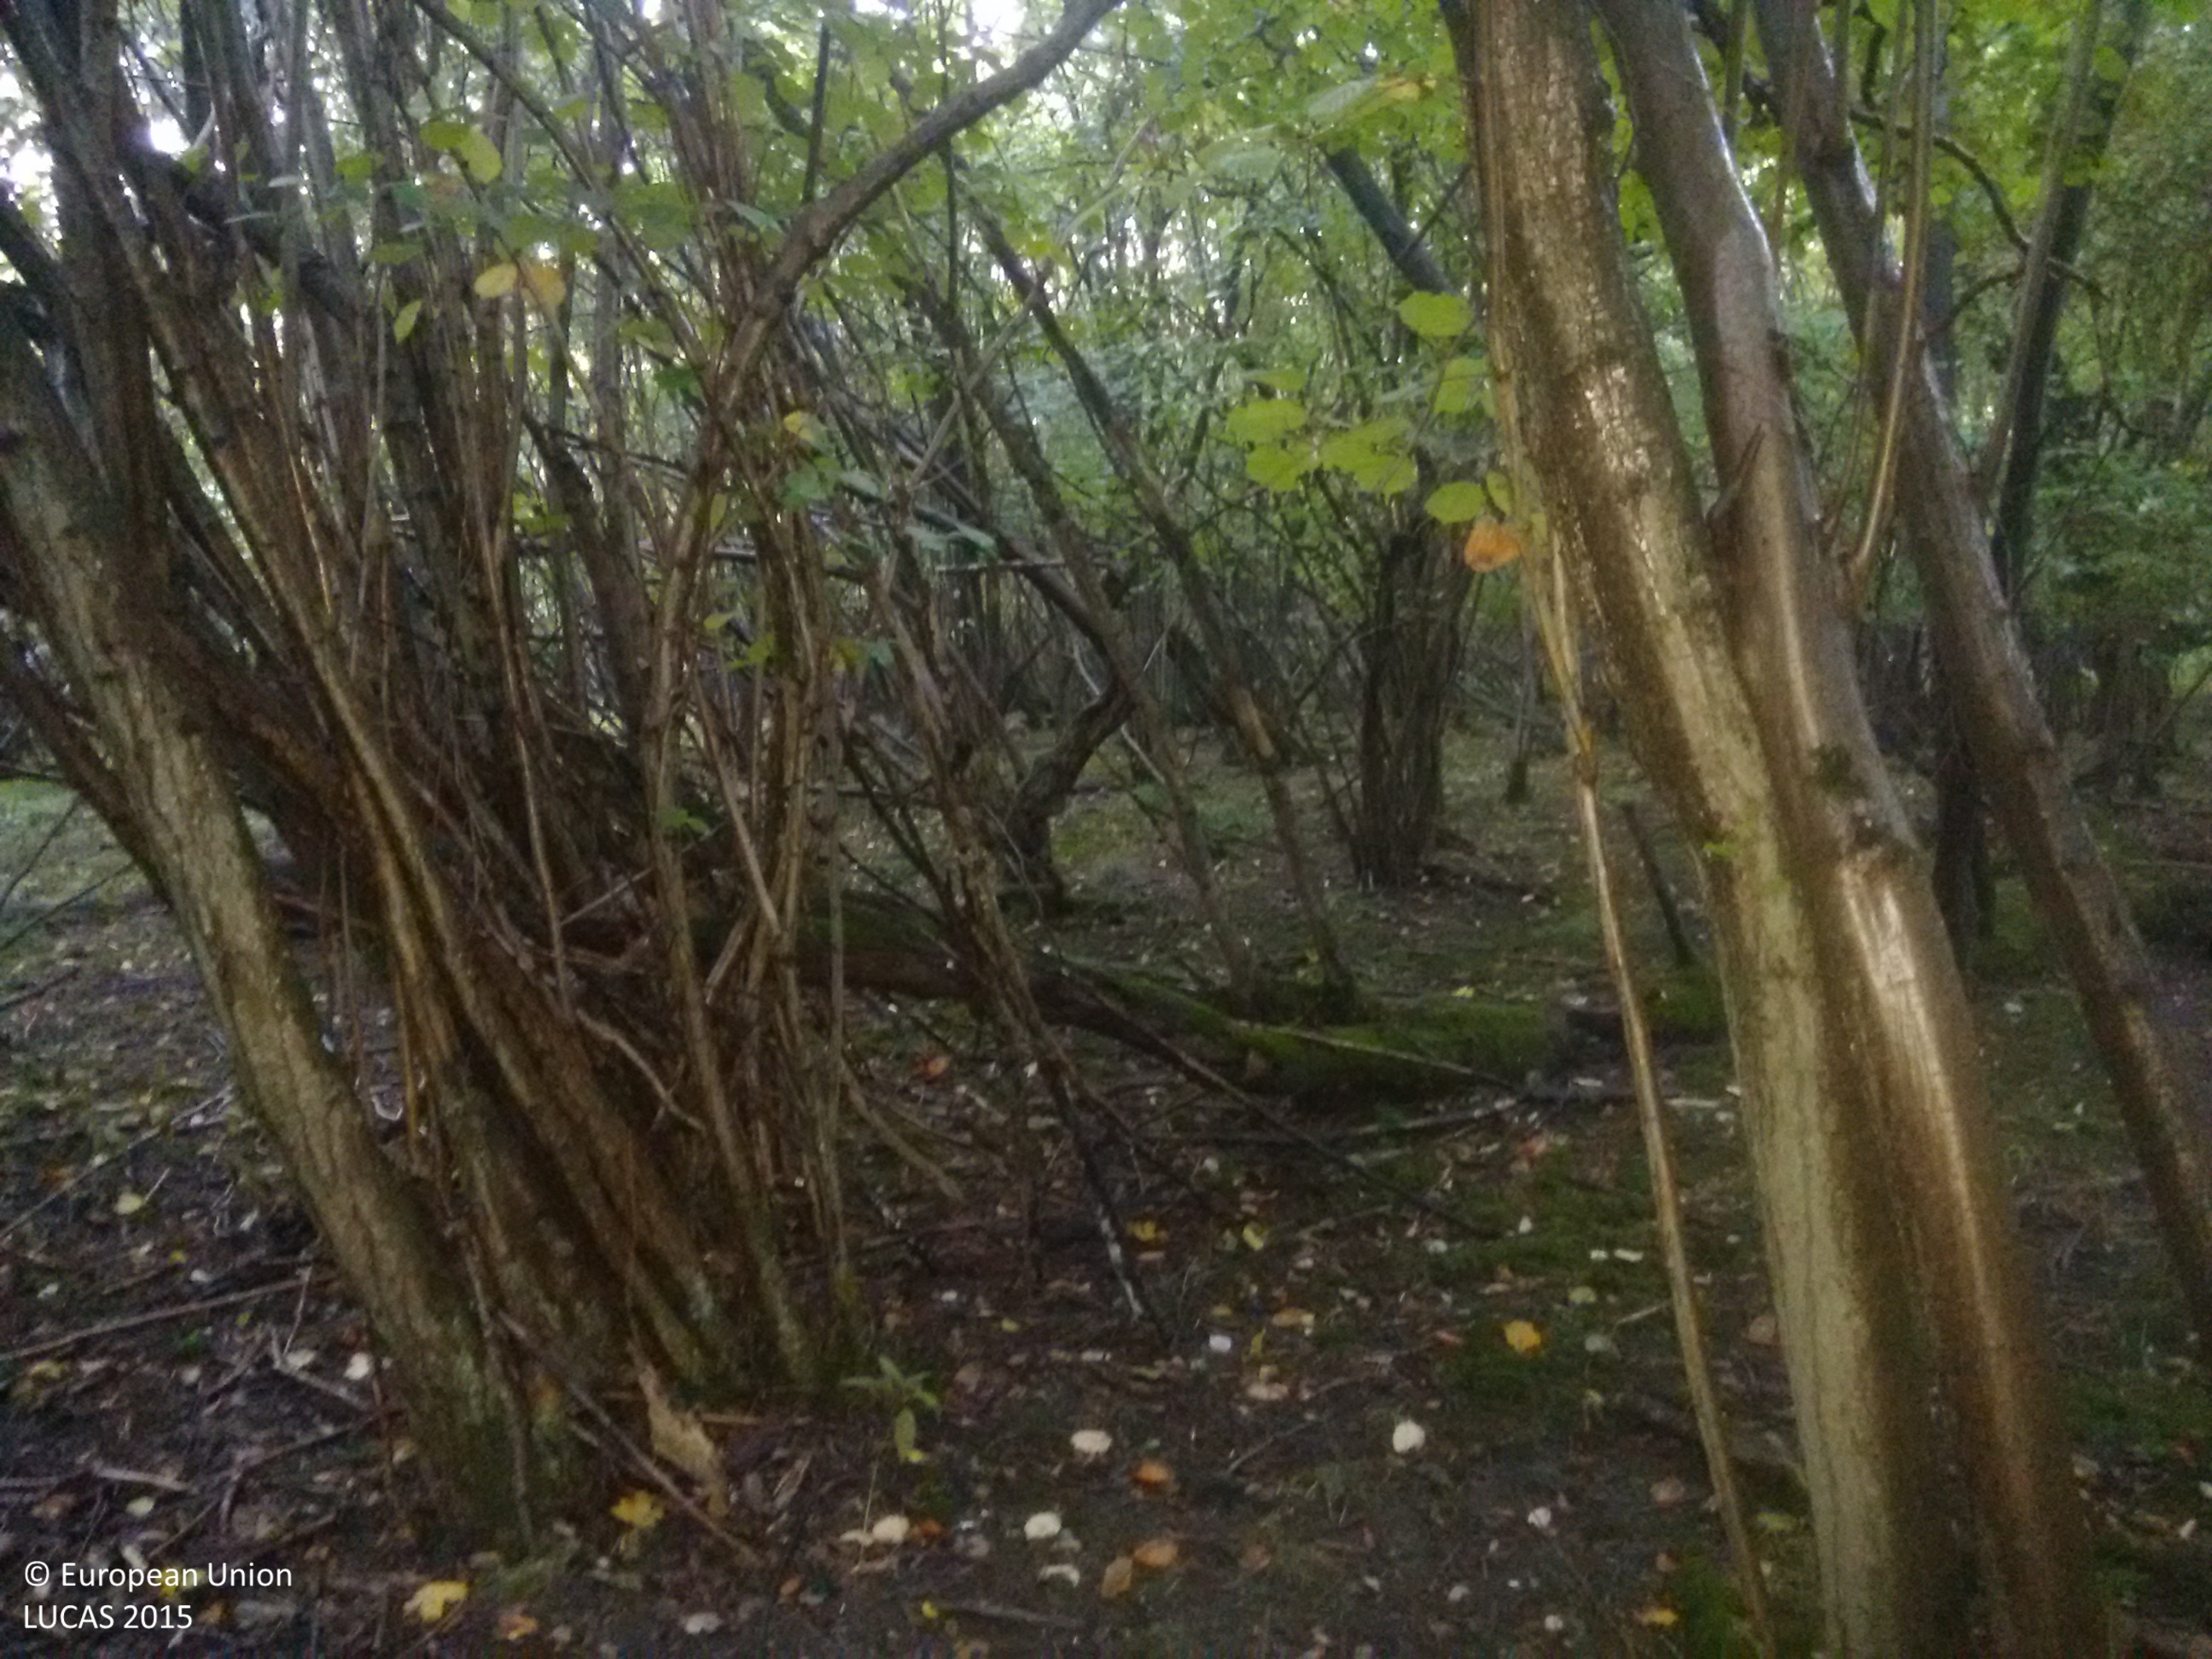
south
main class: Woodland
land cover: Broadleaved woodland
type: mesophytic deciduous forest
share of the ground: > 75 %
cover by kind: broadleaved forest trees 75 %, shrubs 25 %
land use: Semi-natural and natural areas not in use
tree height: > 5 m
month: October
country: GB
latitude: 52.0650
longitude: 0.2402
